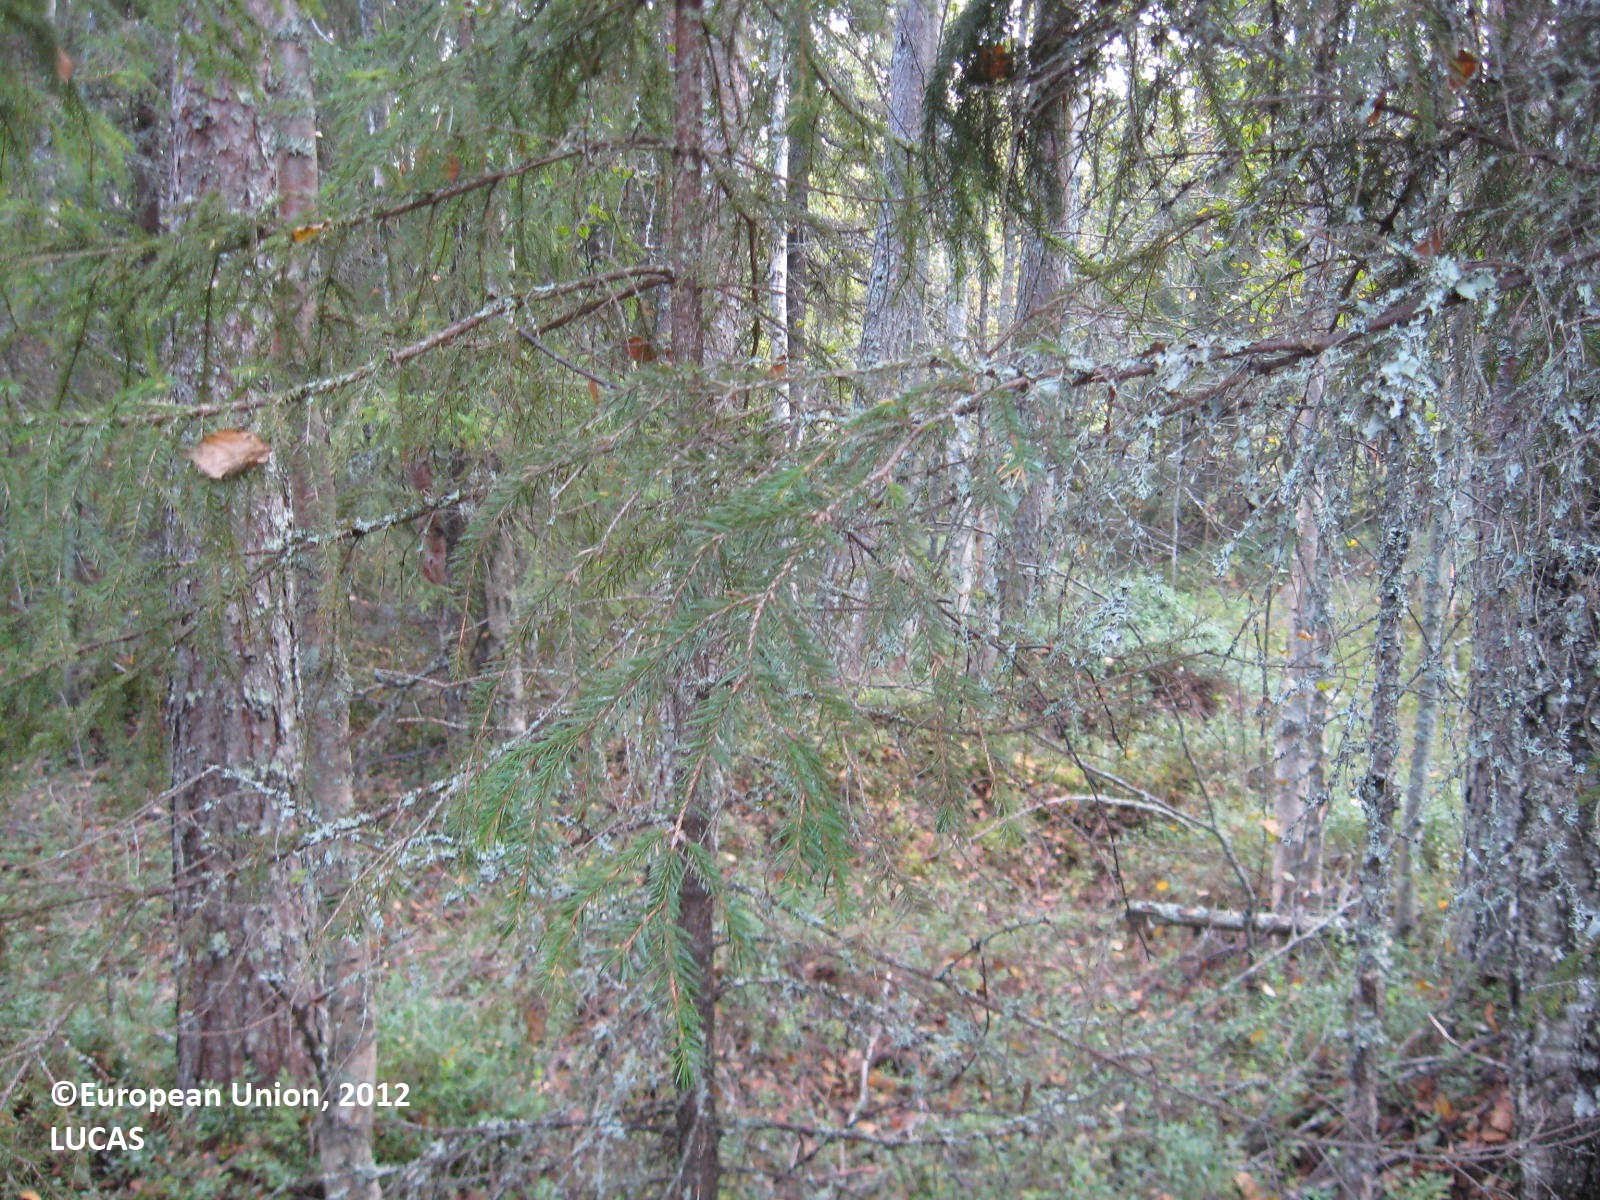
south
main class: Woodland
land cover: Pine dominated mixed woodland
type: boreal forest
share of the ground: > 75 %
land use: Forestry
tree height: > 5 m
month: August
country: FI
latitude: 63.6434
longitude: 29.2958
